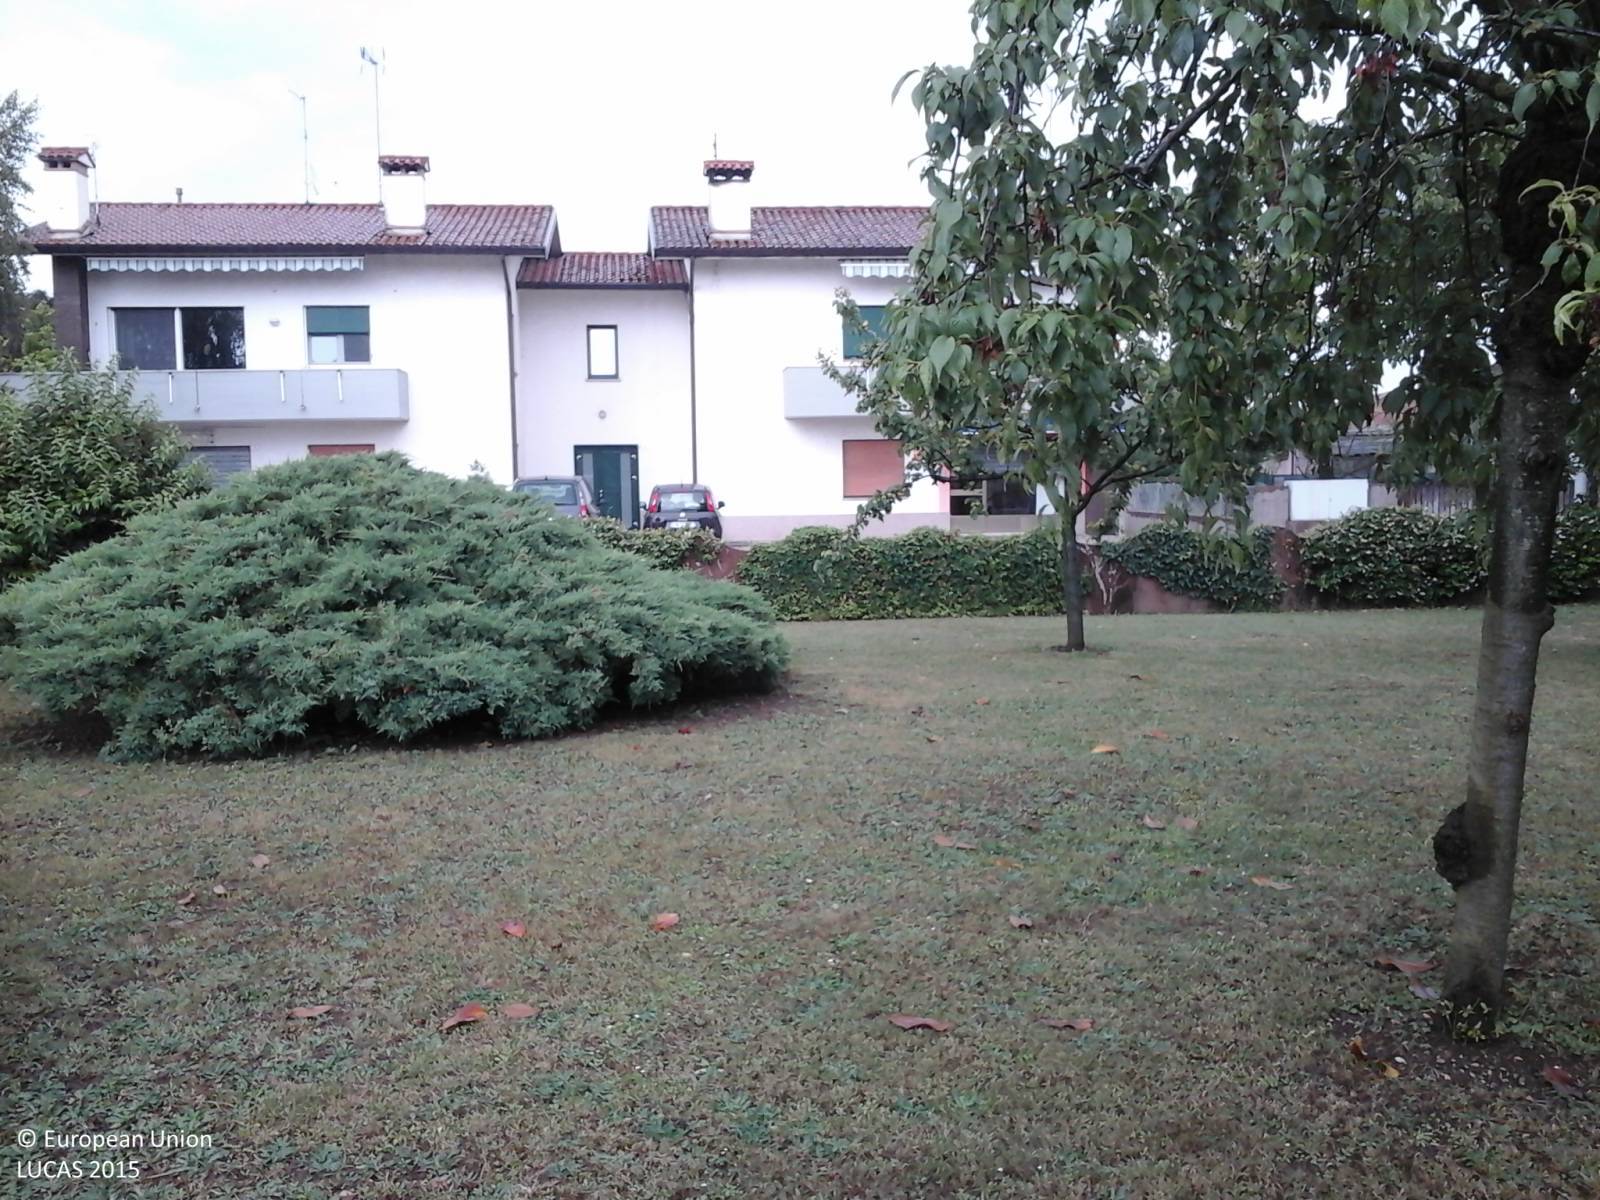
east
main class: Grassland
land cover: Grassland with sparse tree/shrub cover
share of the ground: > 75 %
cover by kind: herbaceous plants 80 %, consolidated bare surface 10 %, coniferous forest trees 5 %, shrubs 5 %
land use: Residential
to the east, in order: Grassland with sparse tree/shrub cover; Artificial constructions in urban areas
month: June
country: IT
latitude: 46.0629
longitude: 13.3962
